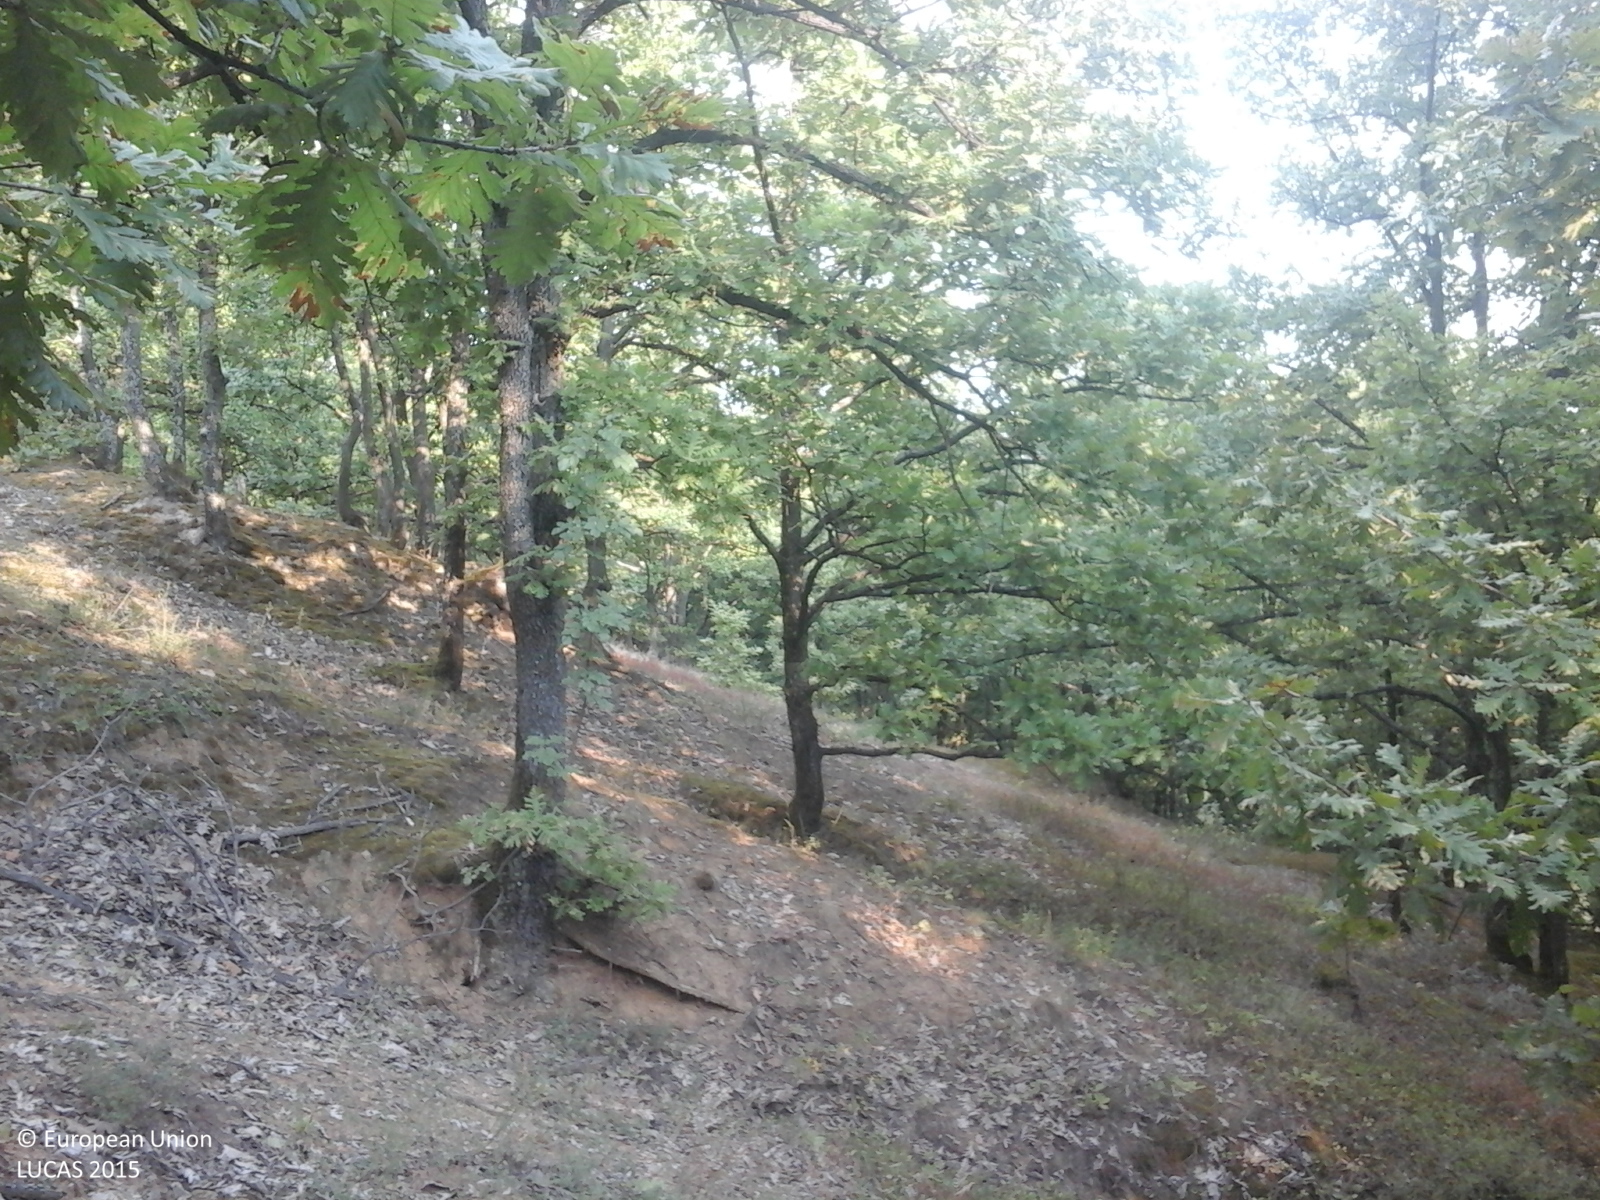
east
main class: Woodland
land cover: Broadleaved woodland
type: acidophilous oak and oak-birch forest
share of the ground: > 75 %
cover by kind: broadleaved forest trees 100 %
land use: Forestry
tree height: > 5 m
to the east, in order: Broadleaved woodland
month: August
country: RO
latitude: 44.6511
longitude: 23.6374
